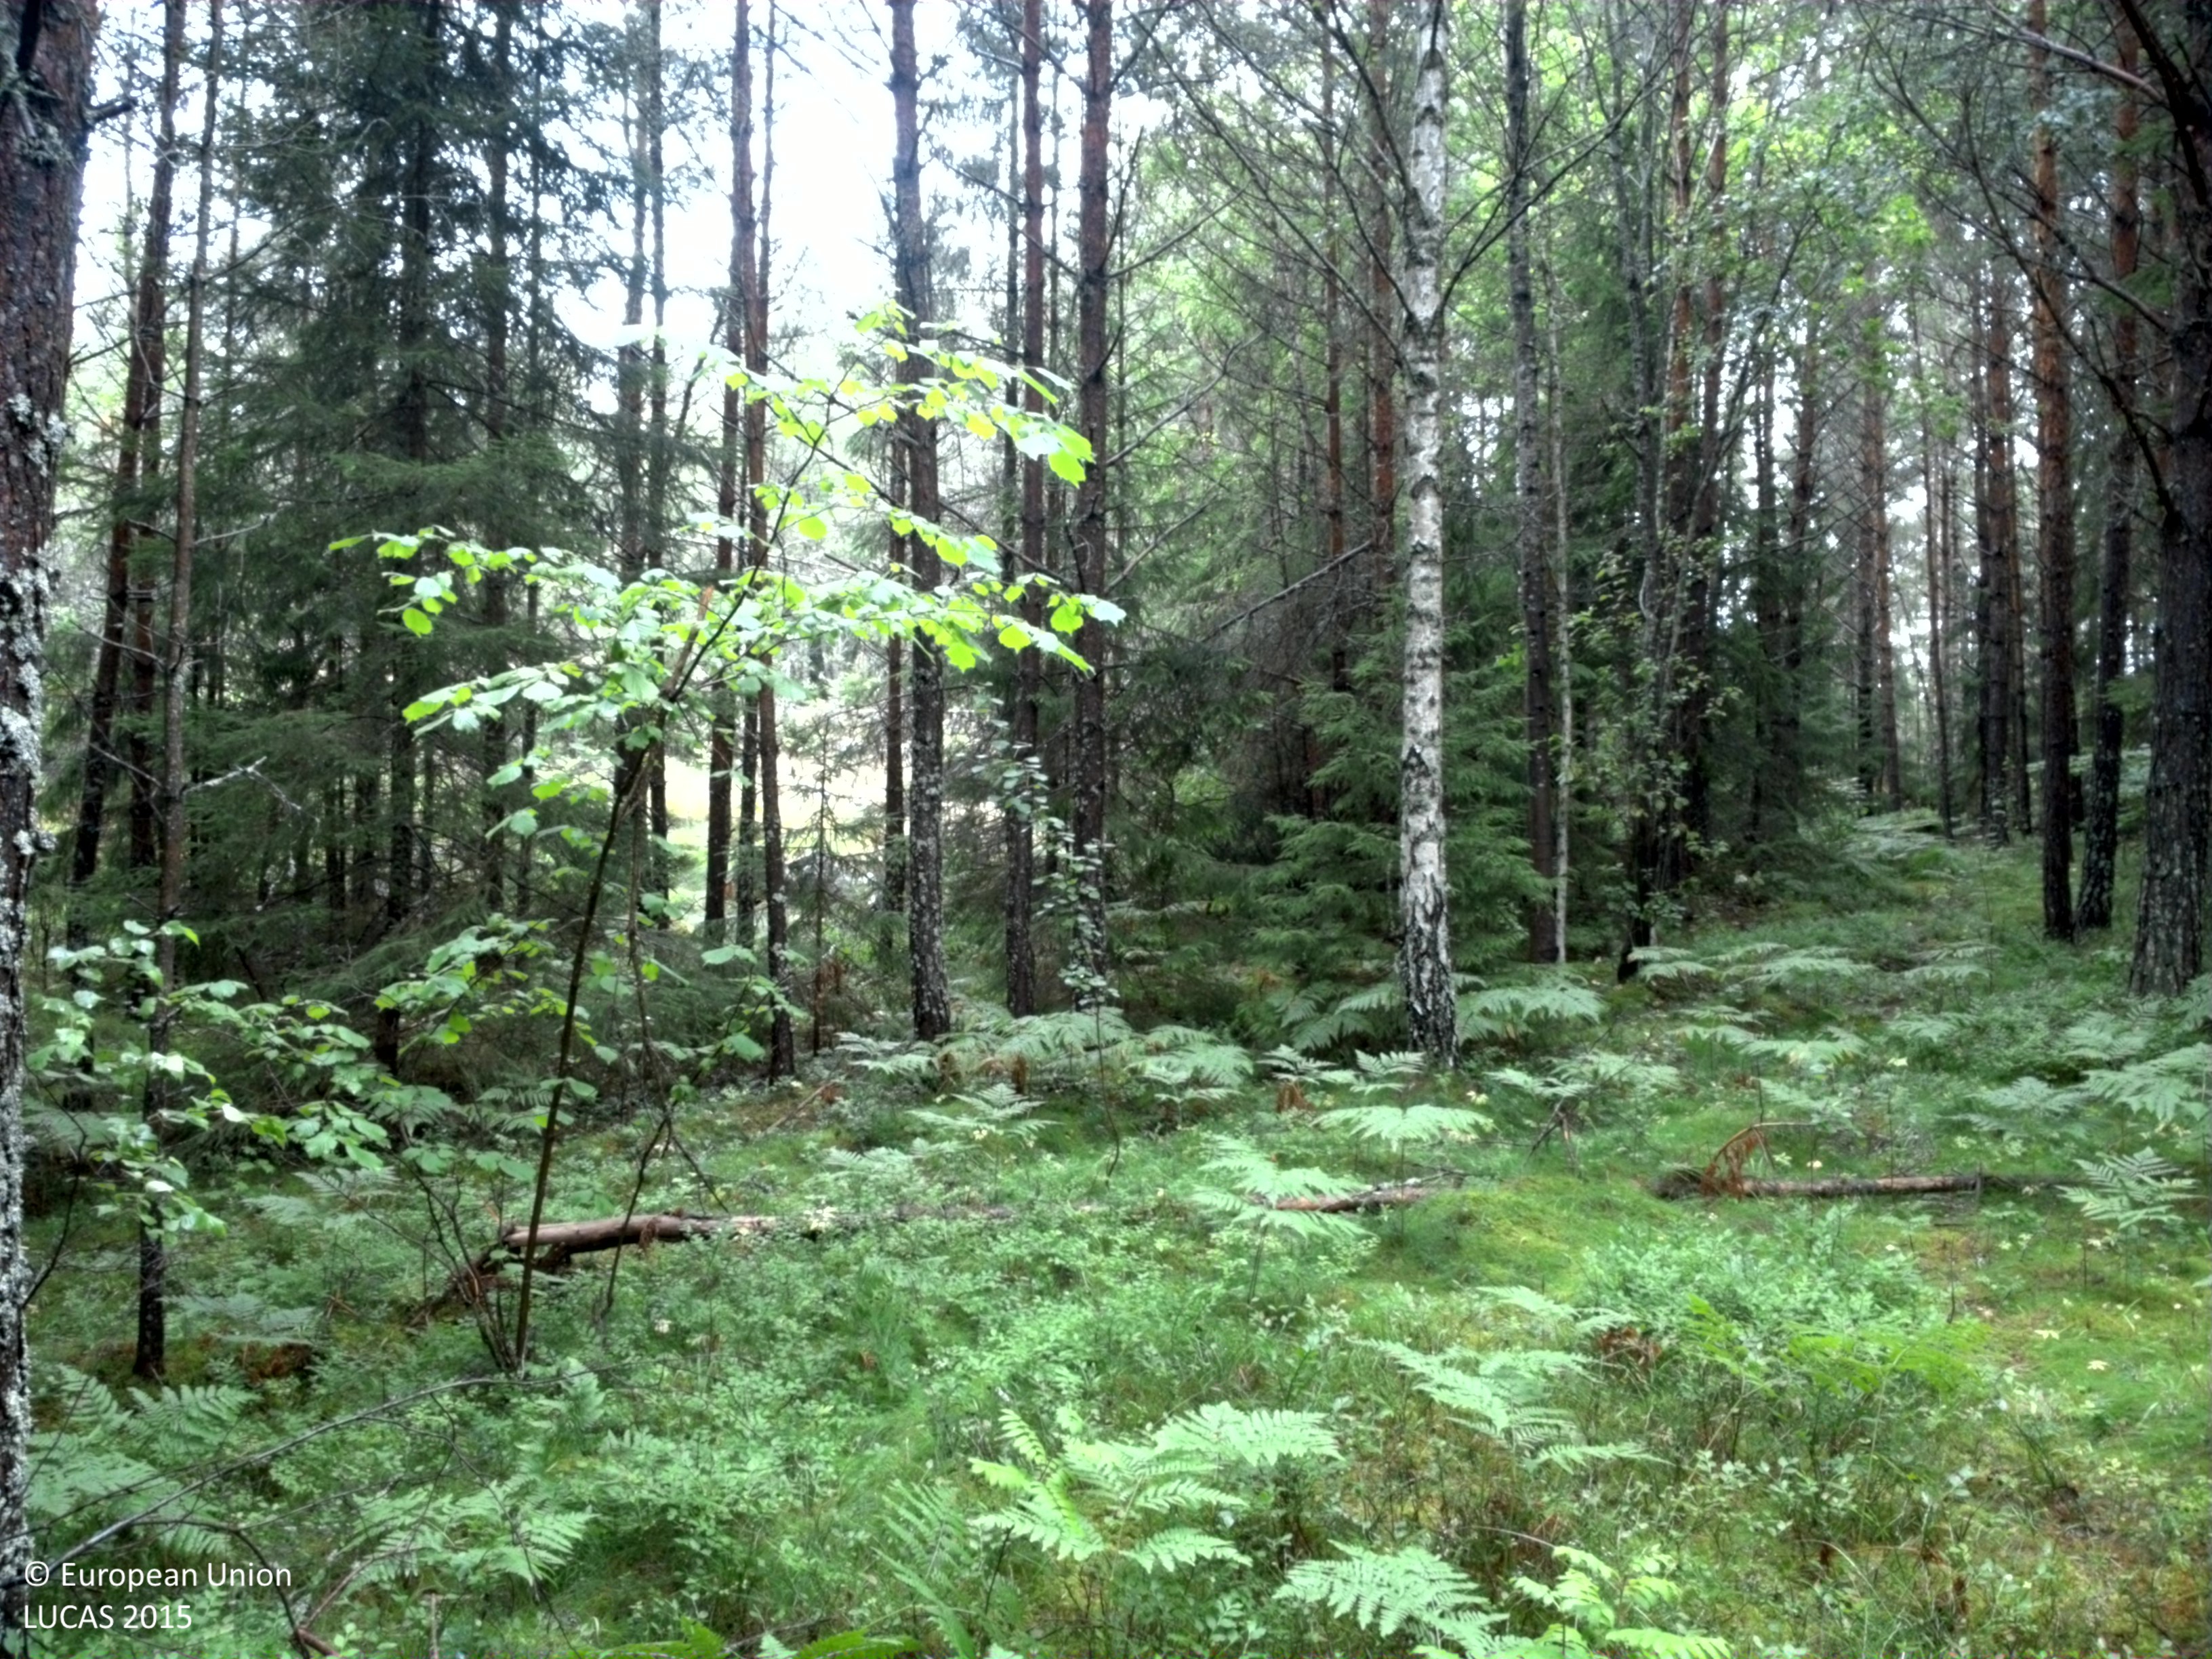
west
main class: Woodland
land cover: Spruce dominated coniferous woodland
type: boreal forest
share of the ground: 50 - 75 %
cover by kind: coniferous forest trees 60 %, lichens and mosses 35 %, broadleaved forest trees 5 %
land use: Forestry
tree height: > 5 m
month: July
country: SE
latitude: 59.6748
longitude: 18.7188
